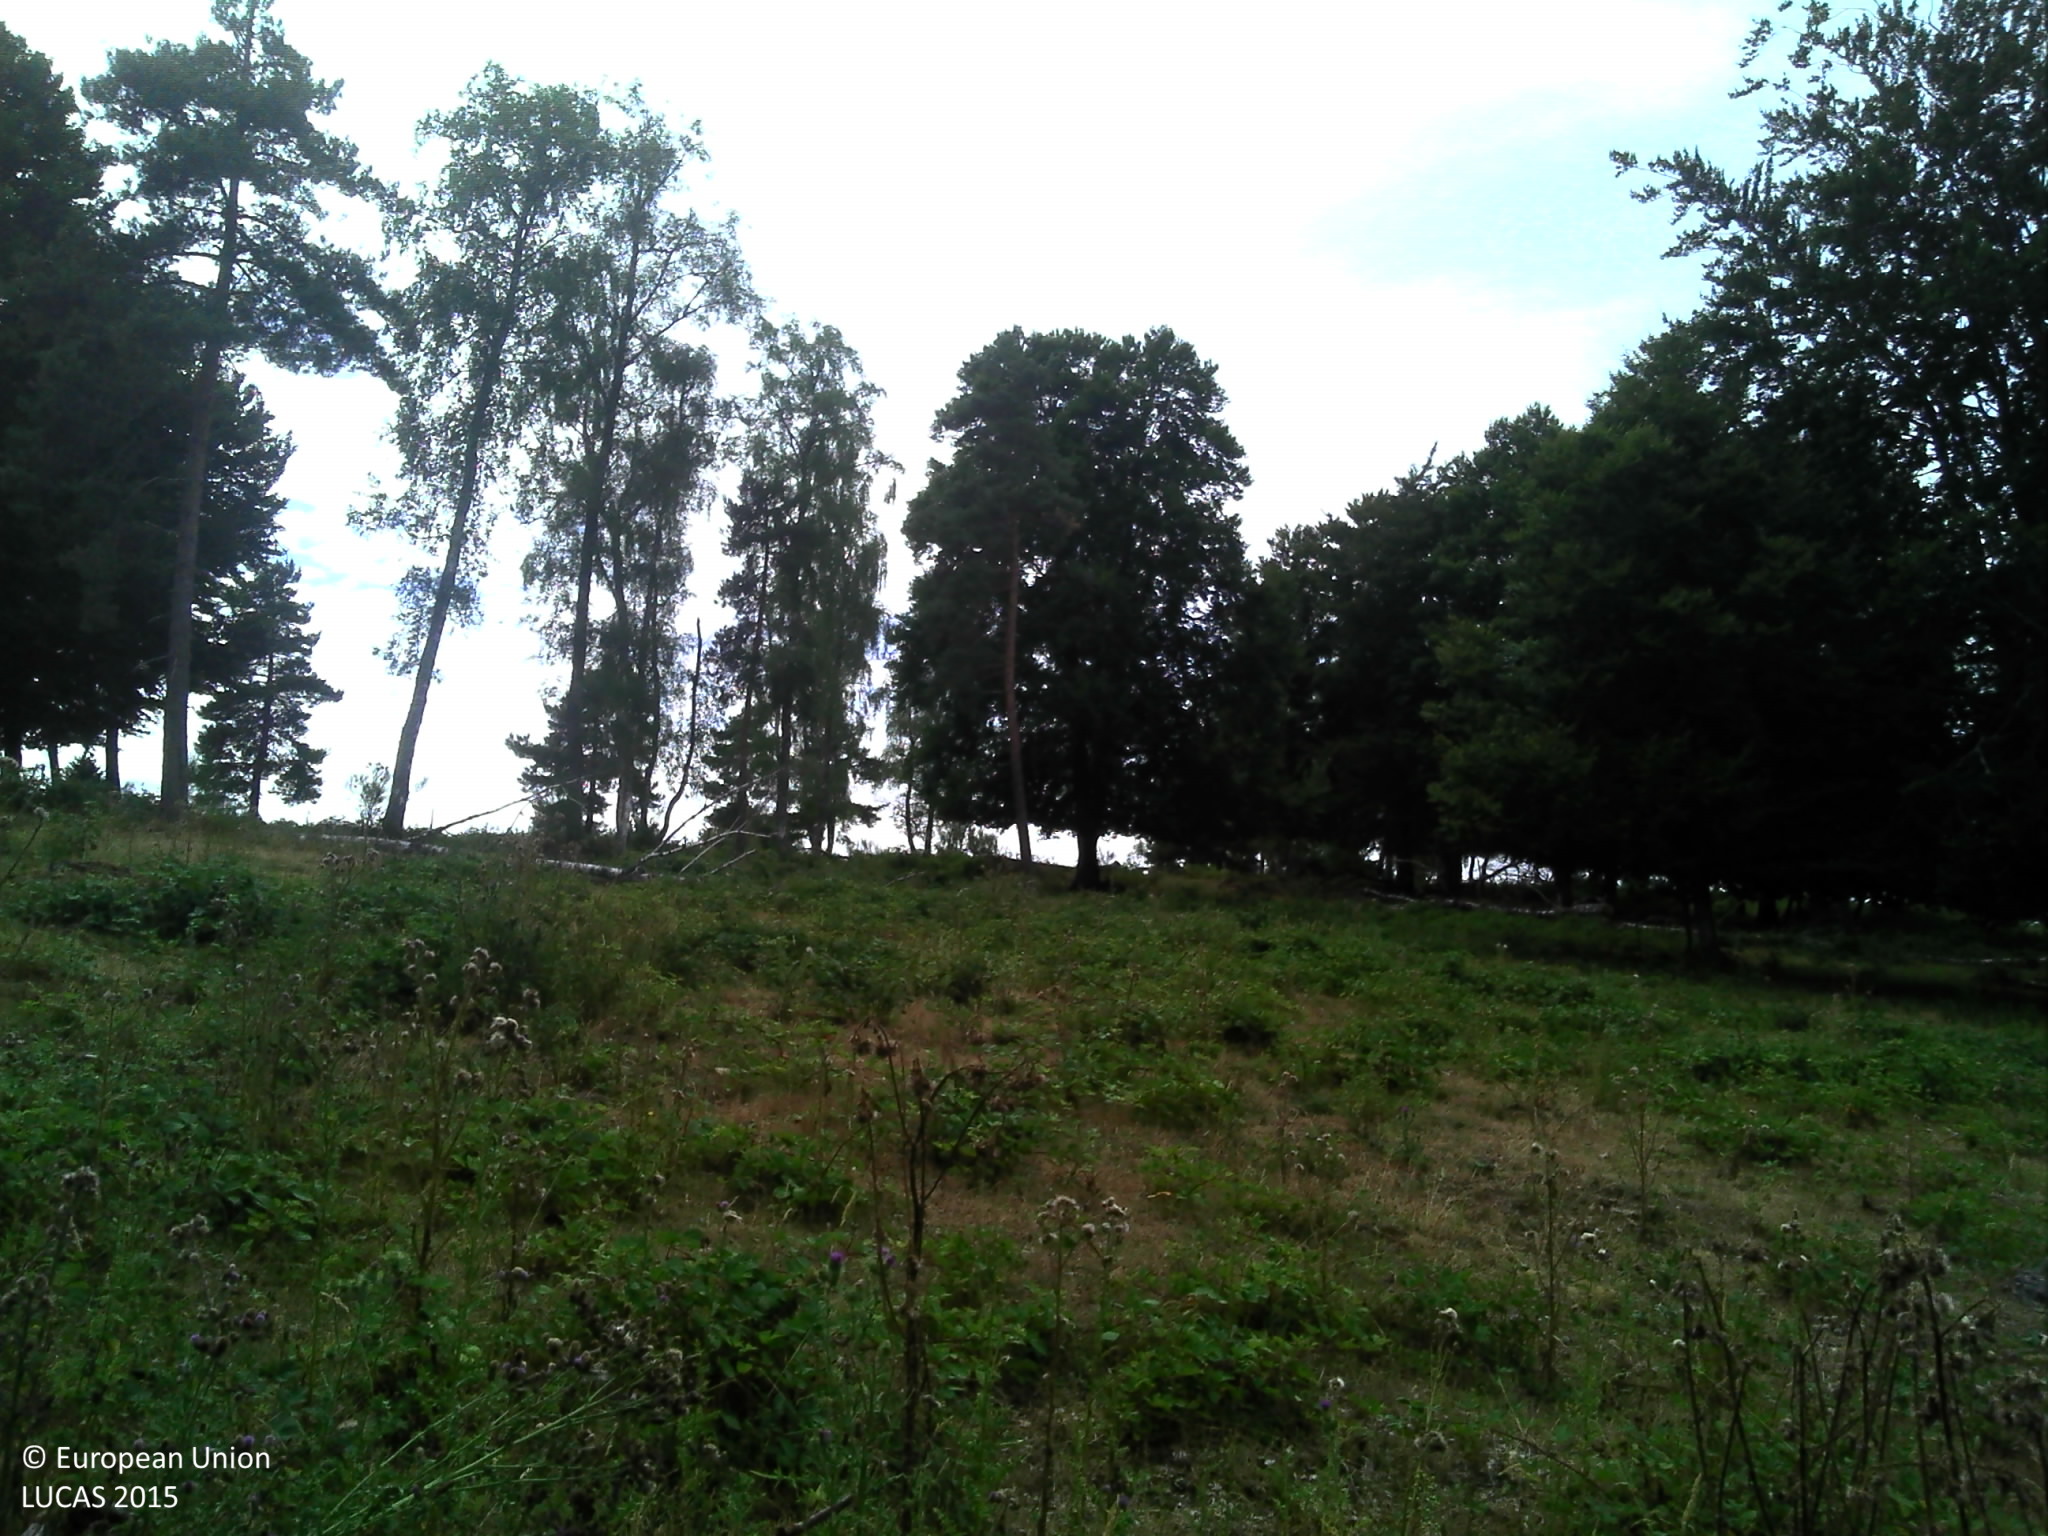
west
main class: Grassland
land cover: Grassland with sparse tree/shrub cover
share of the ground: > 75 %
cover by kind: herbaceous plants 85 %, shrubs 10 %, broadleaved forest trees 5 %
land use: Agriculture (excluding fallow land and kitchen gardens)
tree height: < 5 m
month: July
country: FR
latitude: 44.8842
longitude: 3.1537
